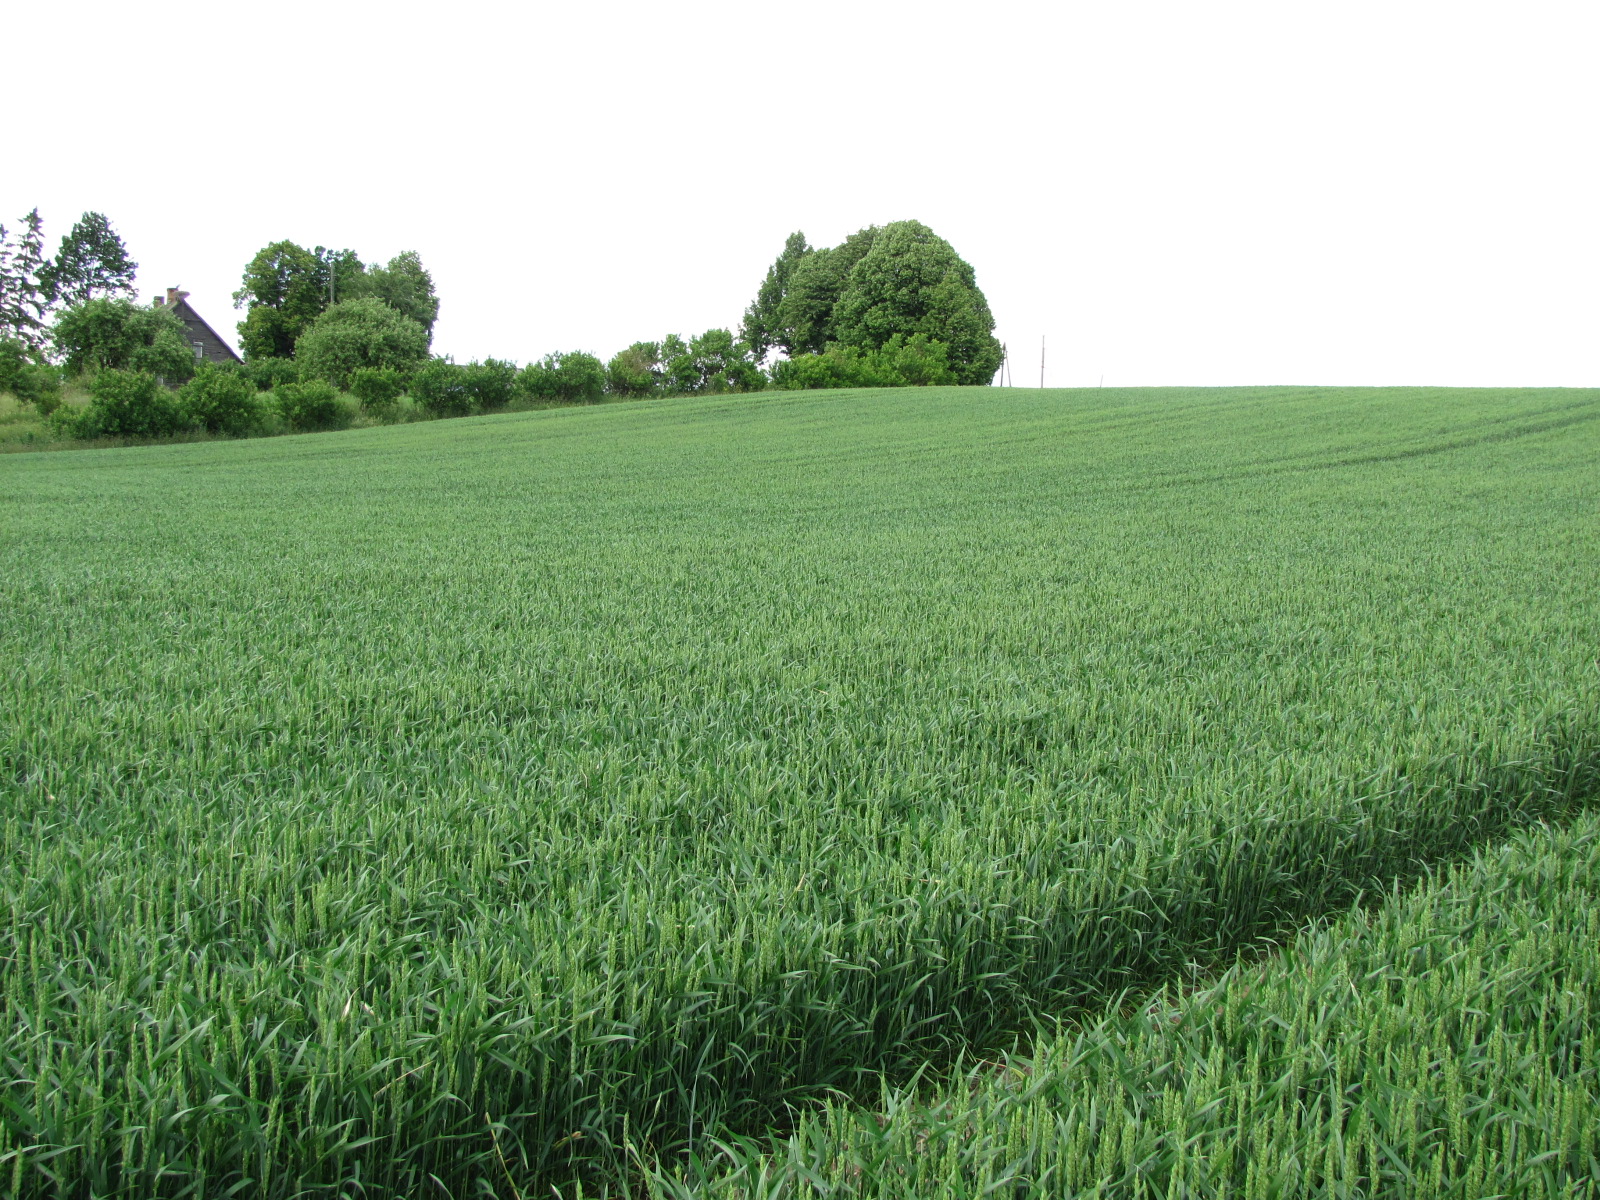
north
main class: Cropland
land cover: Common wheat
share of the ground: > 75 %
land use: Agriculture (excluding fallow land and kitchen gardens)
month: June
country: LV
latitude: 56.4756
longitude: 23.9985
